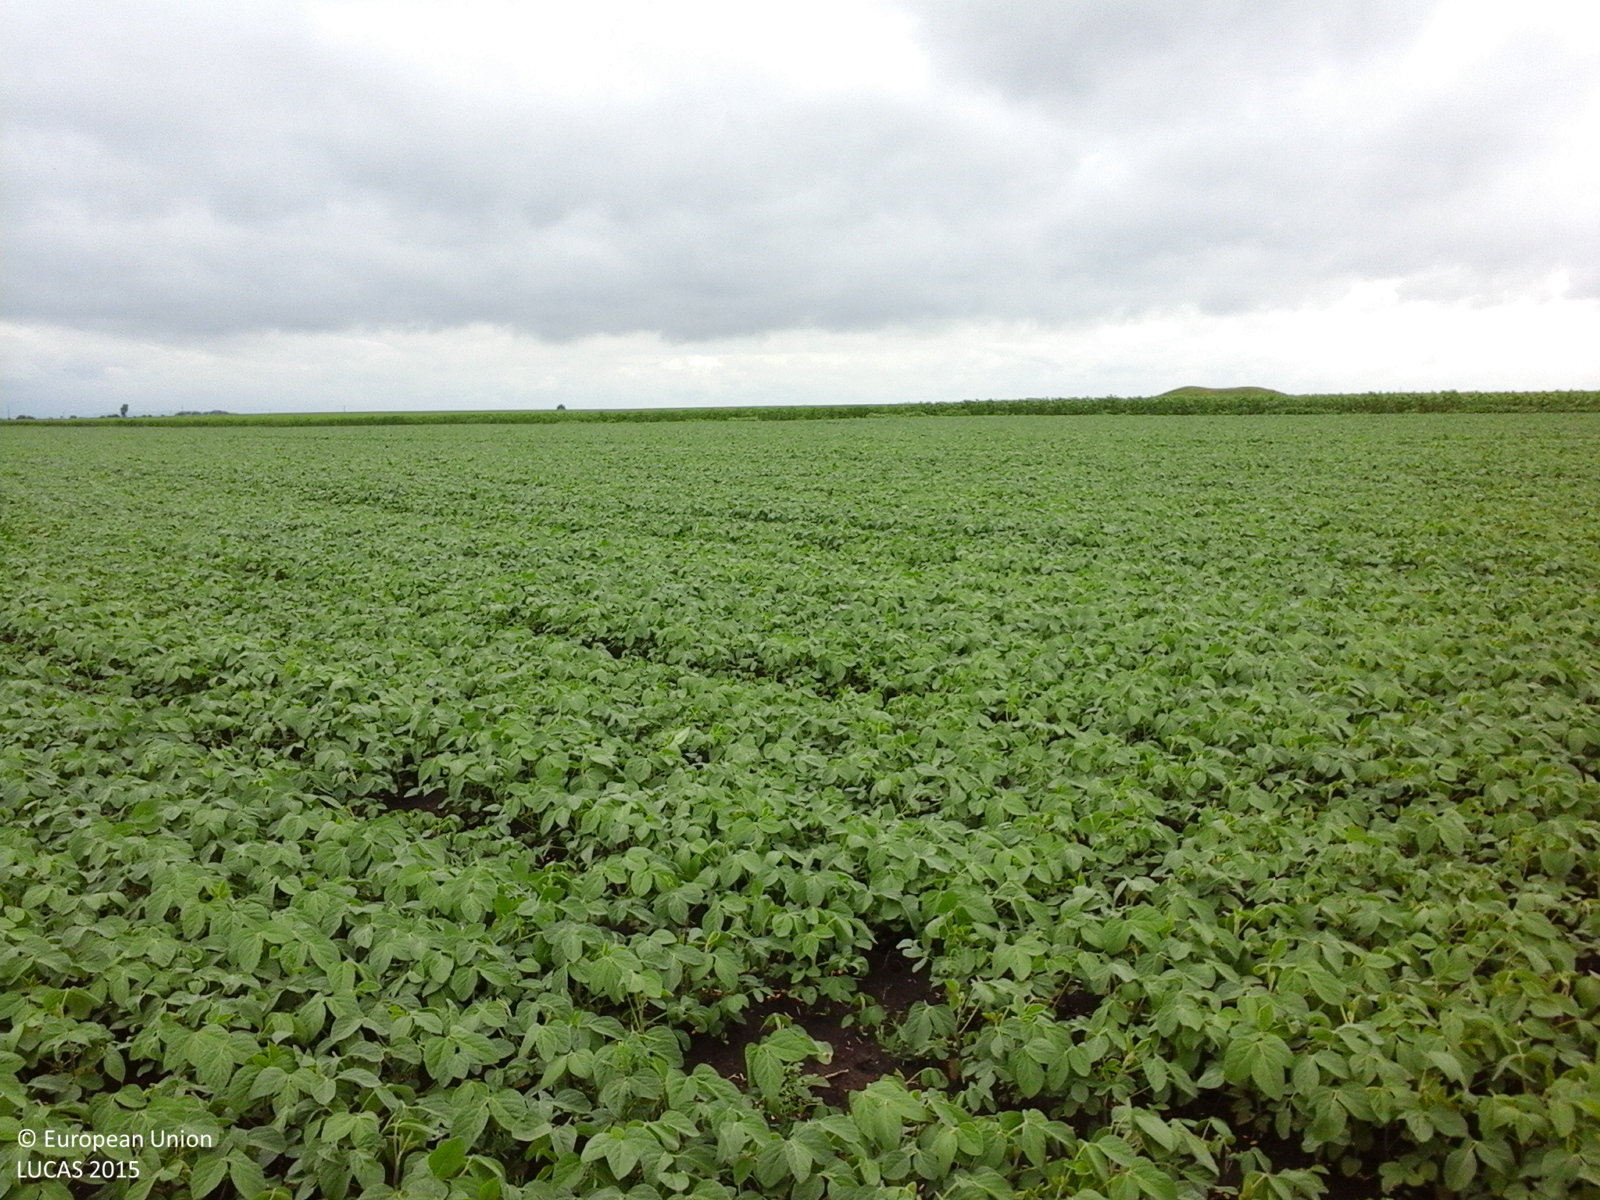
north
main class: Cropland
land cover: Soya
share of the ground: > 75 %
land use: Agriculture (excluding fallow land and kitchen gardens)
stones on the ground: < 10 %
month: June
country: RO
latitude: 47.9823
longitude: 26.4771
